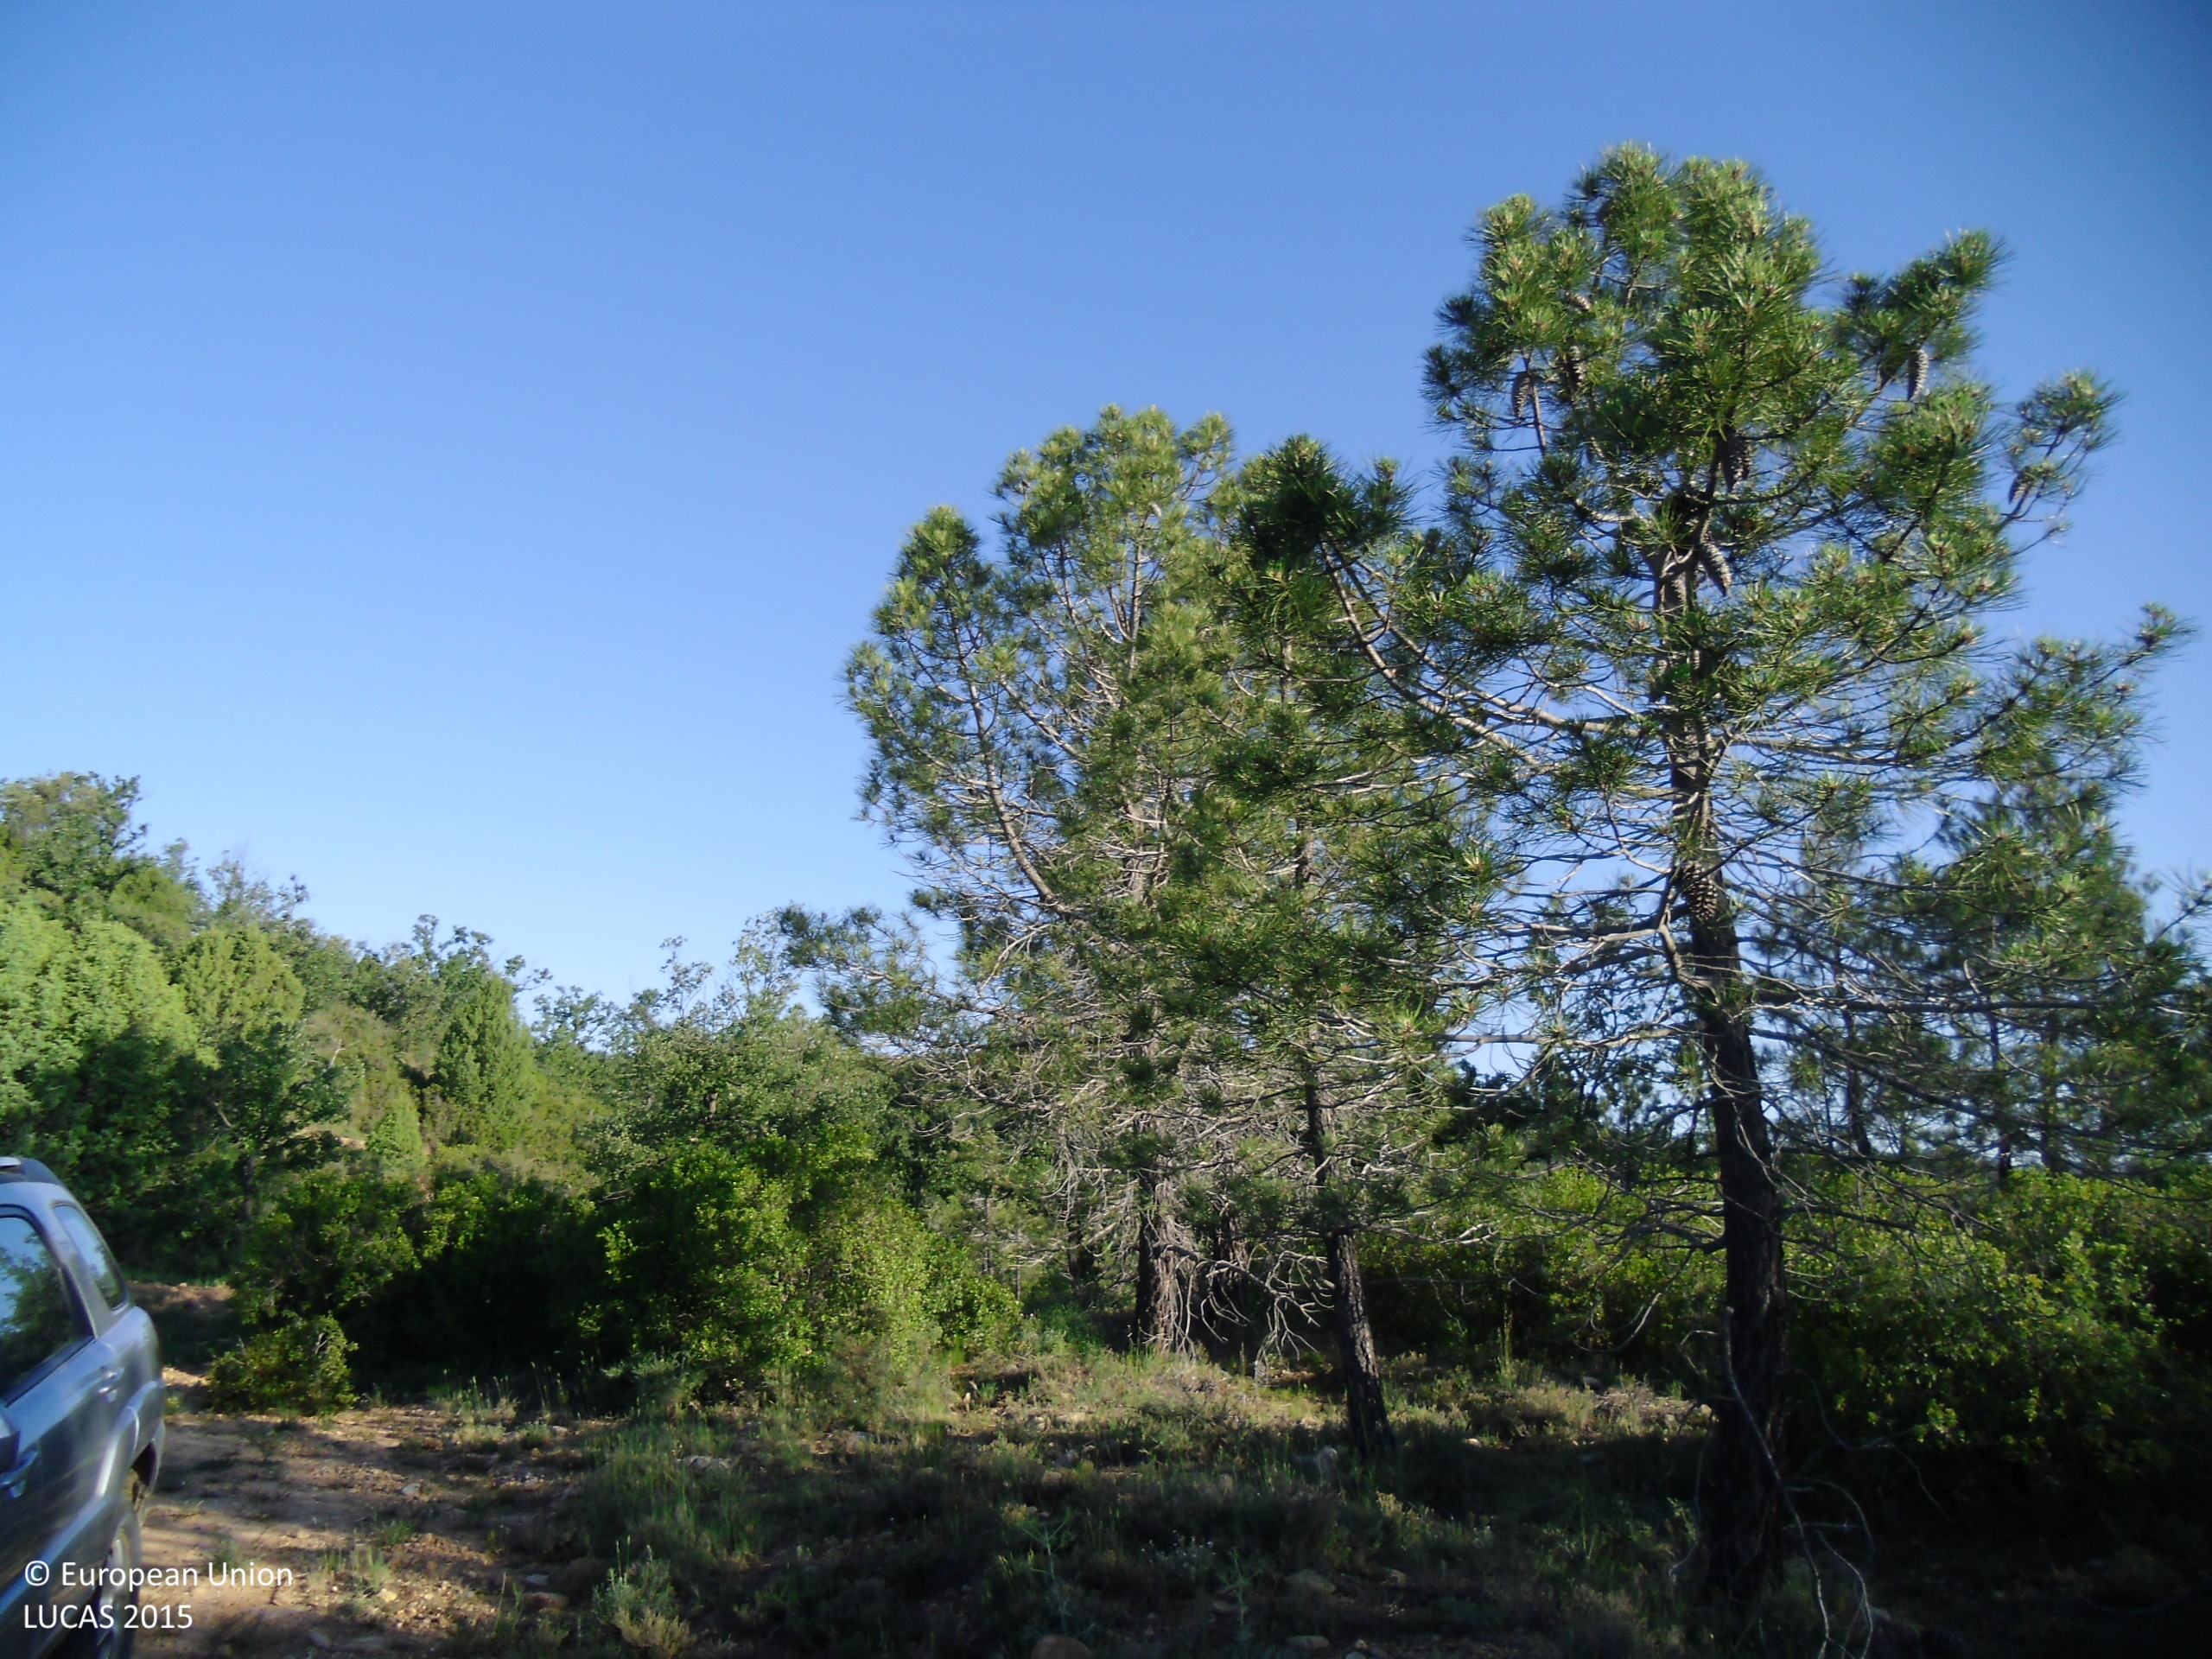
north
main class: Woodland
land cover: Pine dominated mixed woodland
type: coniferous forest of the mediterranean region
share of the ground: 50 - 75 %
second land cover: Shrubland without tree cover
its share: 25 - 50 %
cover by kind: coniferous forest trees 35 %, shrubs 25 %, broadleaved forest trees 20 %, herbaceous plants 10 %, consolidated bare surface 10 %
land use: Forestry
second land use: Agriculture (excluding fallow land and kitchen gardens)
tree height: > 5 m
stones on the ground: < 10 %
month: May
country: ES
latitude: 40.1903
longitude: -0.7070
